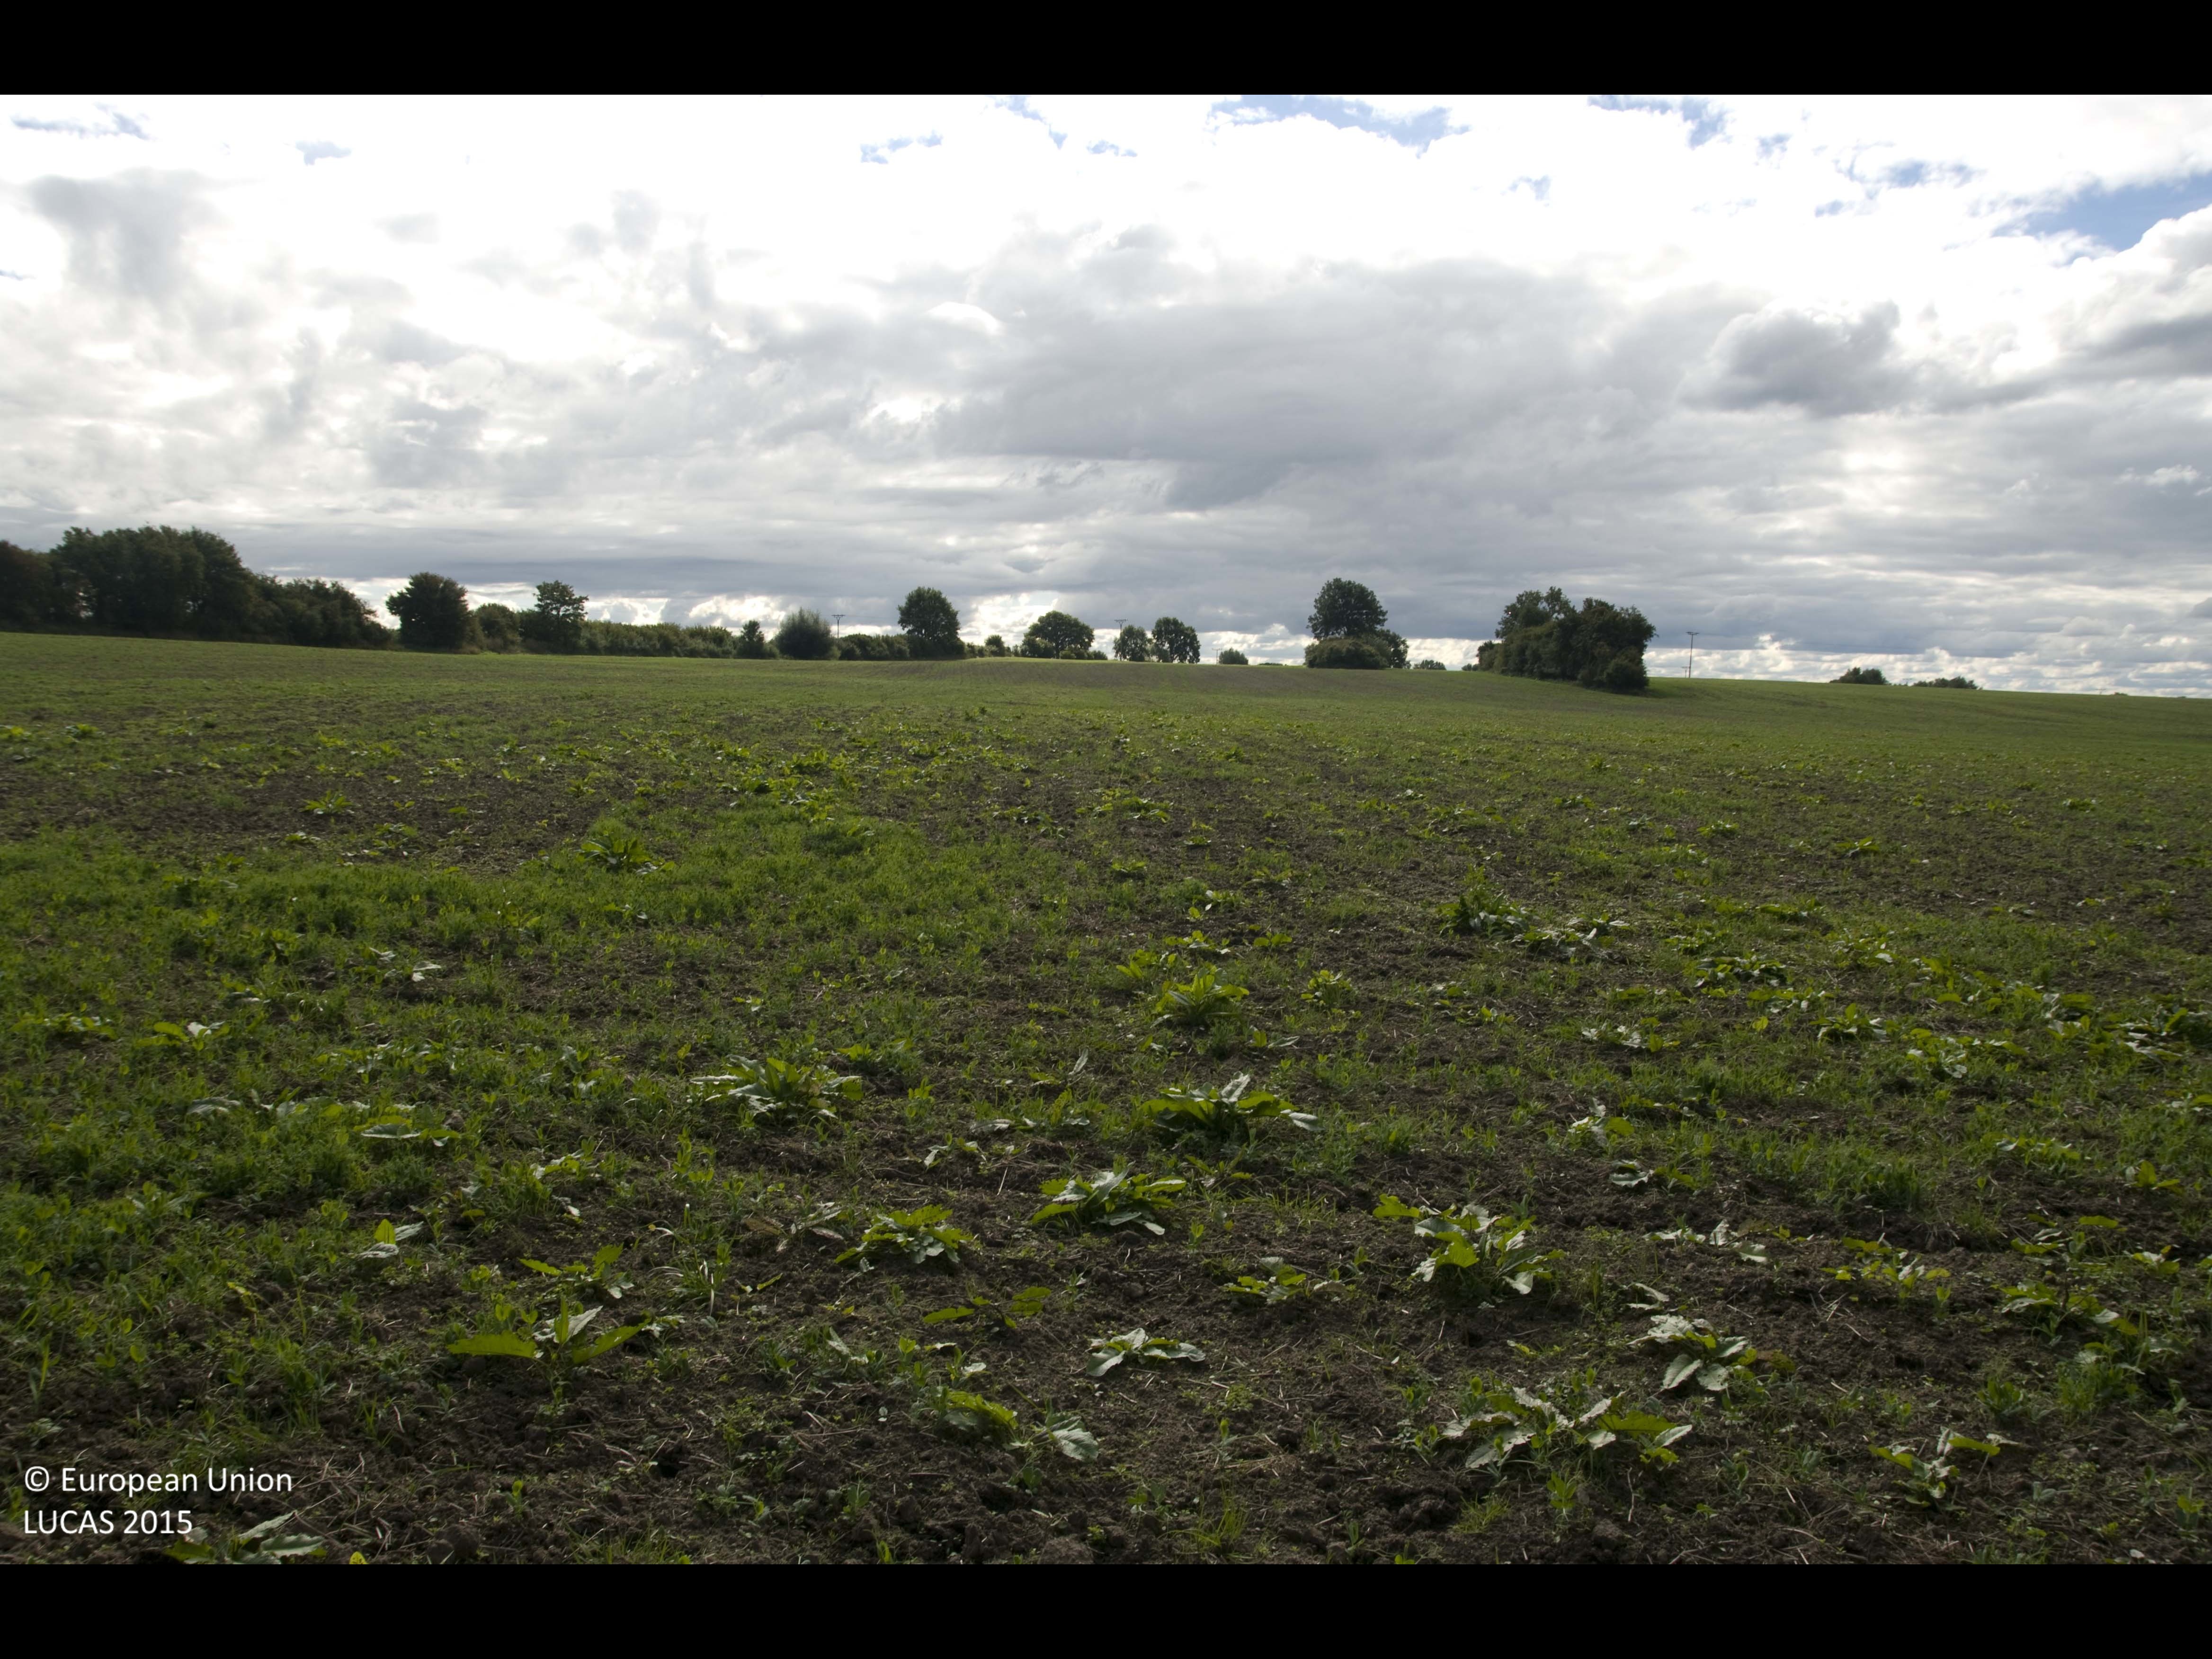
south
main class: Cropland
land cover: Dry pulses
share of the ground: < 10 %
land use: Agriculture (excluding fallow land and kitchen gardens)
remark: Harvested field
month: September
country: DE
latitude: 53.9730
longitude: 10.9904
